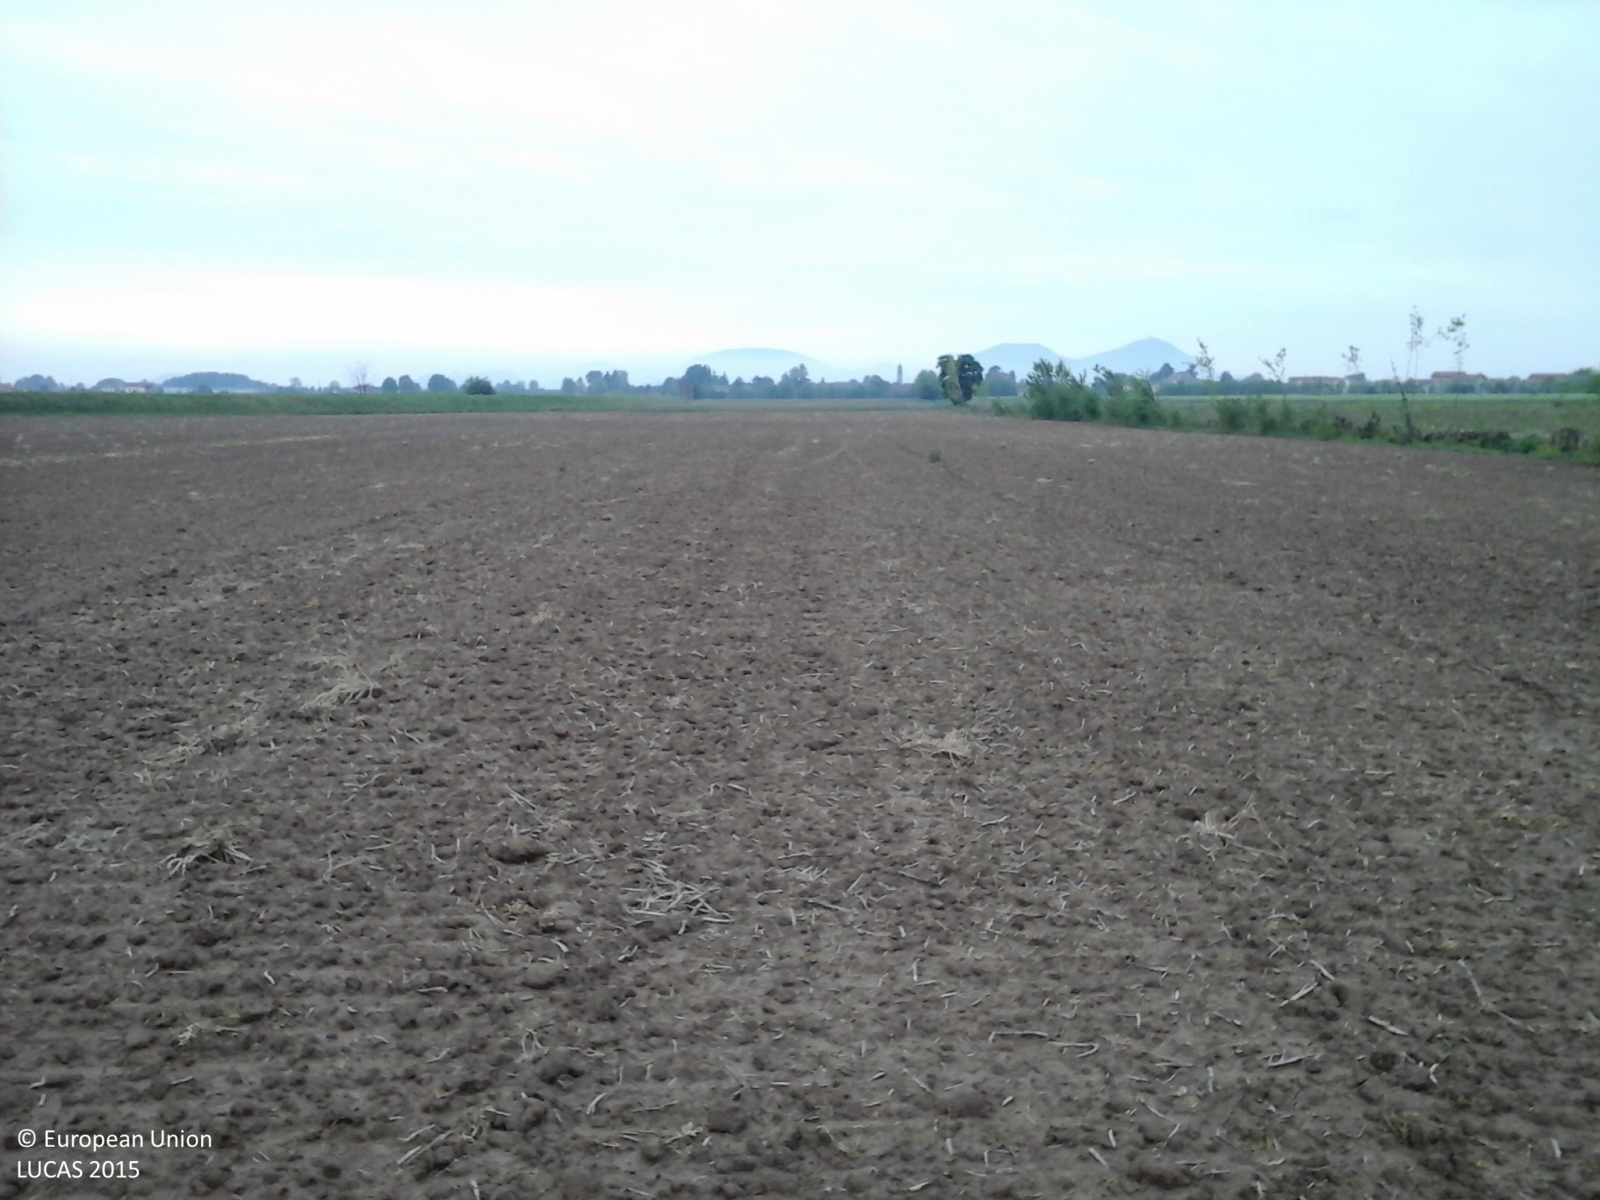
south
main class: Cropland
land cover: Maize
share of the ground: < 10 %
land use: Agriculture (excluding fallow land and kitchen gardens)
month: May
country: IT
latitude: 45.4723
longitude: 11.7240
